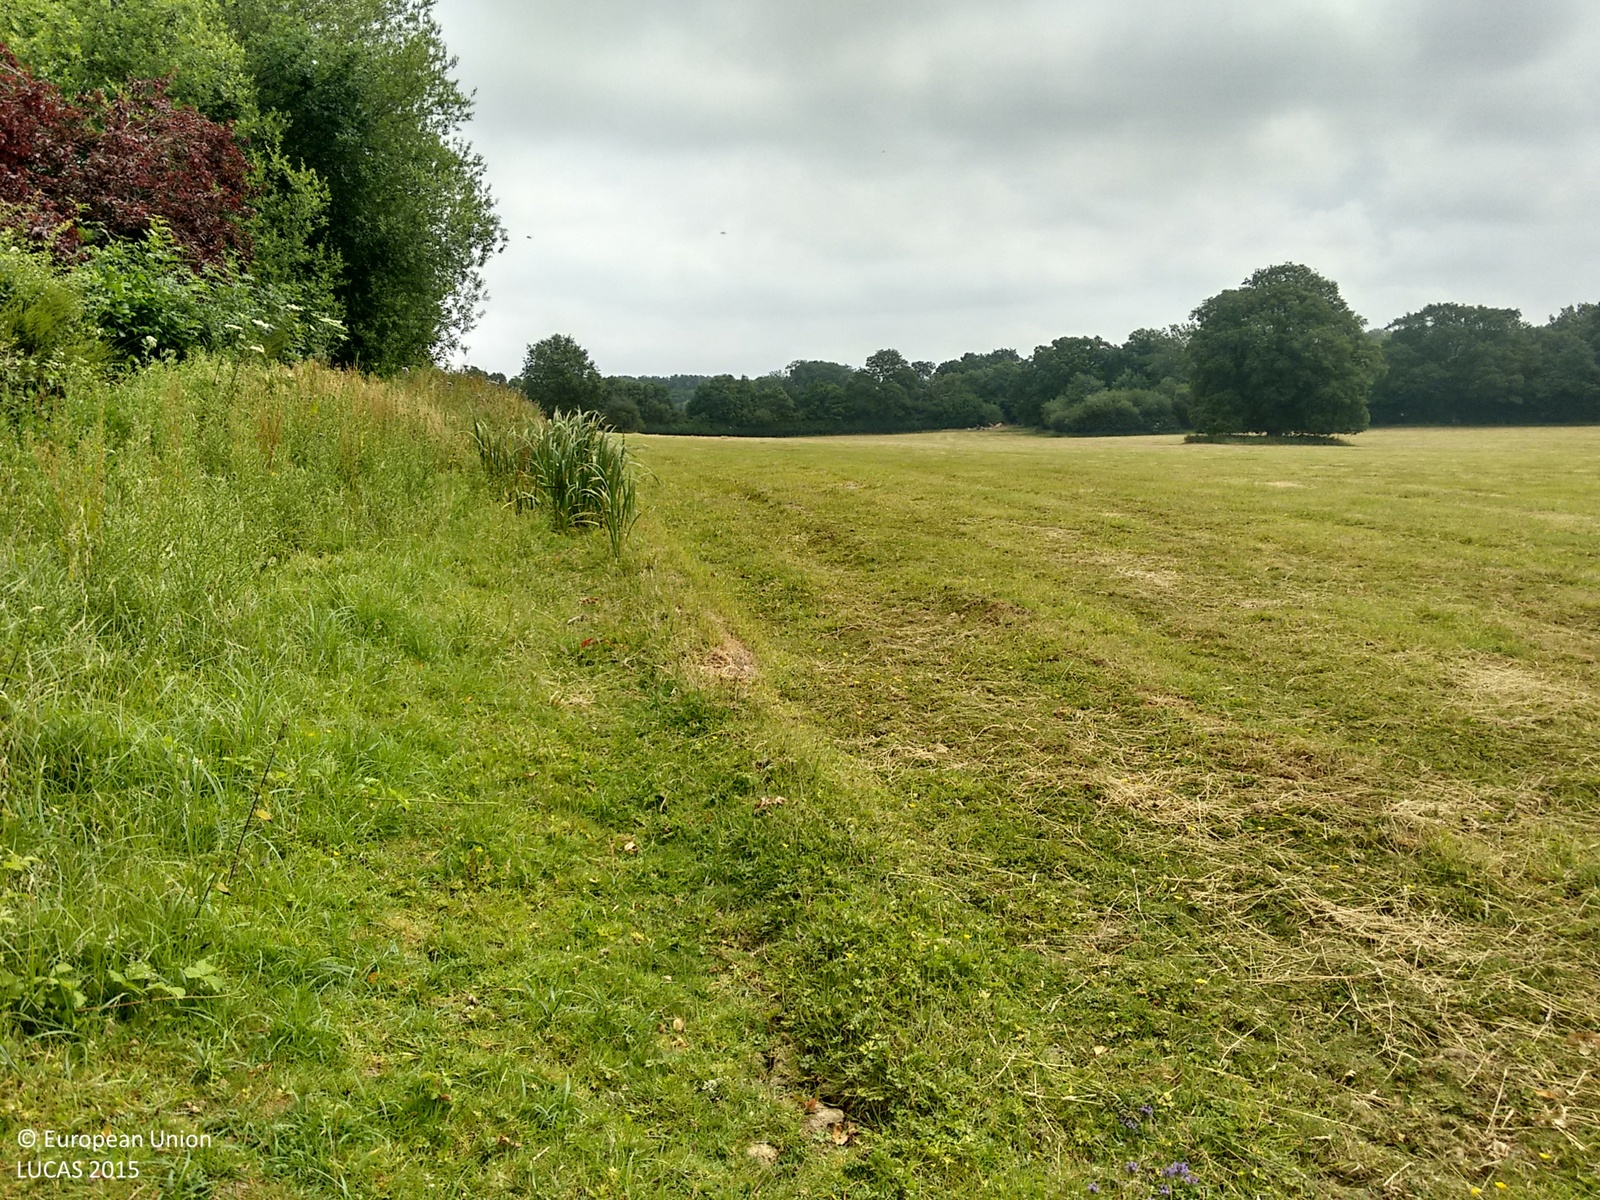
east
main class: Grassland
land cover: Grassland without tree/shrub cover
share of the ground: > 75 %
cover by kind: herbaceous plants 100 %
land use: Agriculture (excluding fallow land and kitchen gardens)
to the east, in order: Grassland without tree/shrub cover
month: July
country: GB
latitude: 51.0331
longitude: -0.1734
